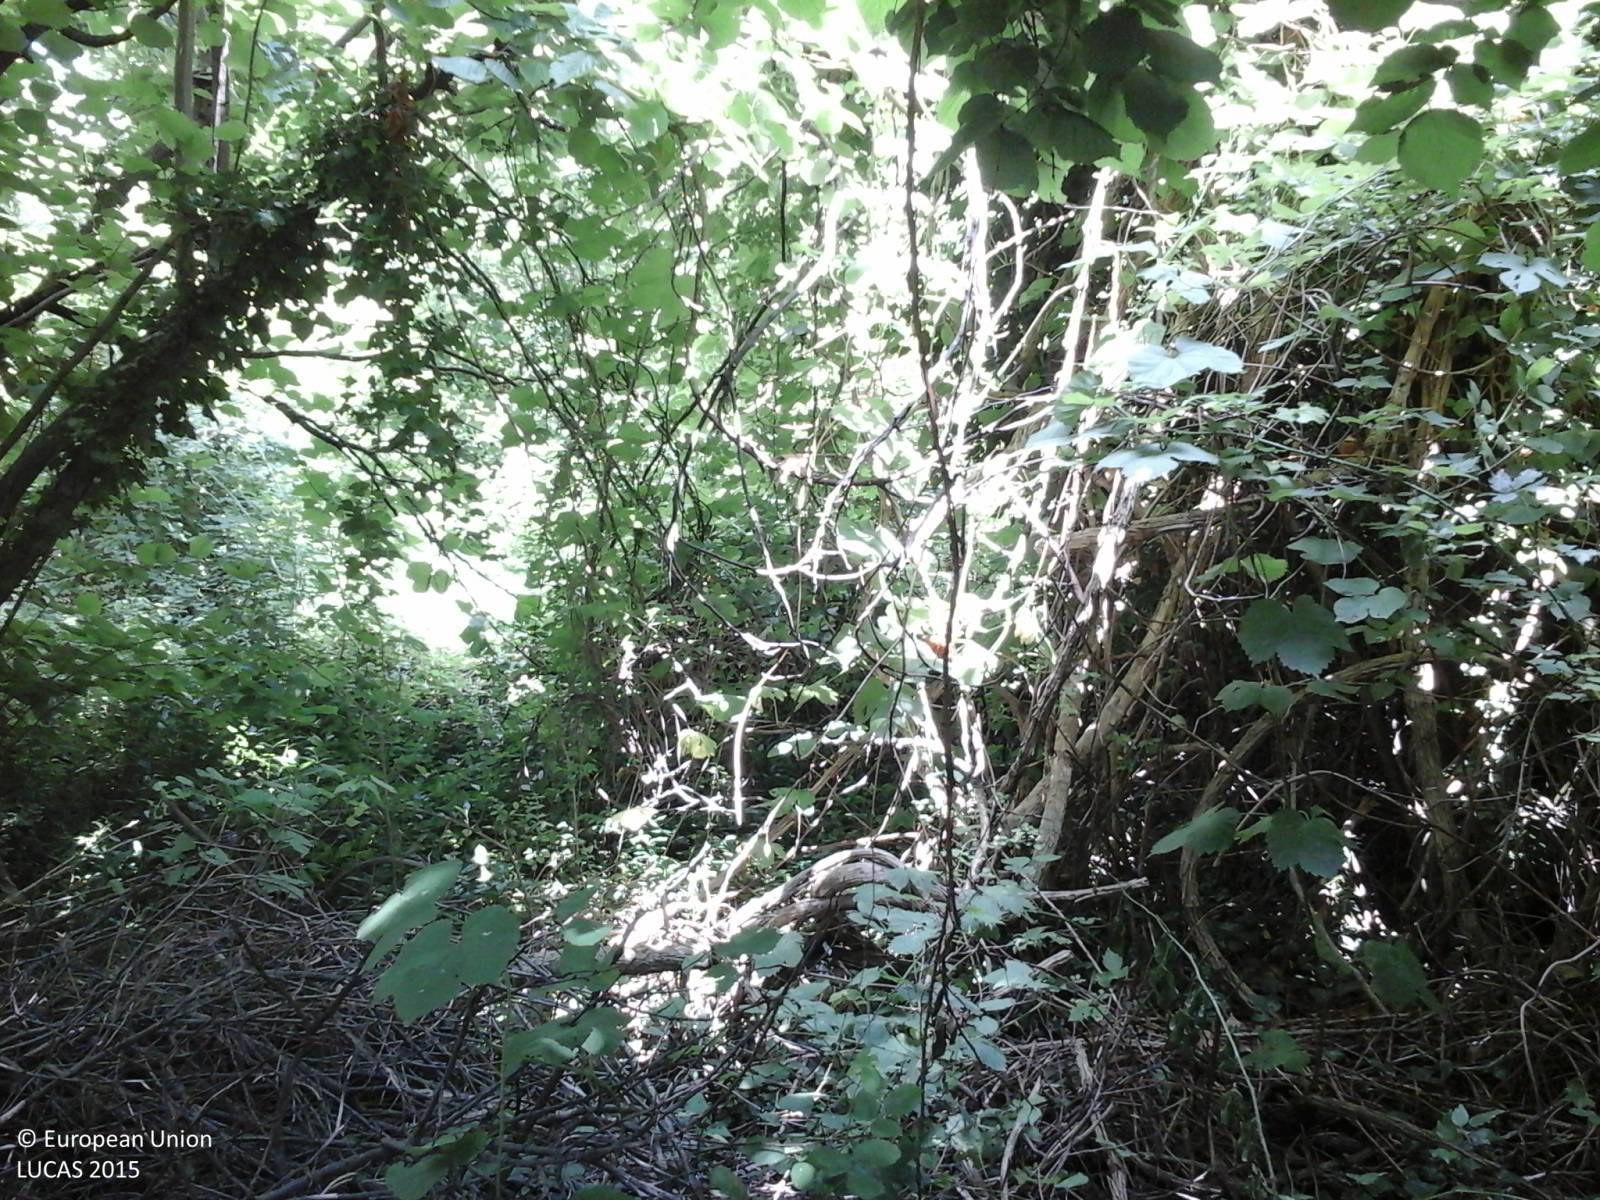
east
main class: Woodland
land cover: Broadleaved woodland
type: thermophilous deciduous forest
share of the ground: > 75 %
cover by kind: broadleaved forest trees 80 %, shrubs 20 %
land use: Semi-natural and natural areas not in use
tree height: > 5 m
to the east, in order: Broadleaved woodland; Tracks; Broadleaved woodland; Inland fresh running water; Broadleaved woodland
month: June
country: IT
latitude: 45.7863
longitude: 13.5846
